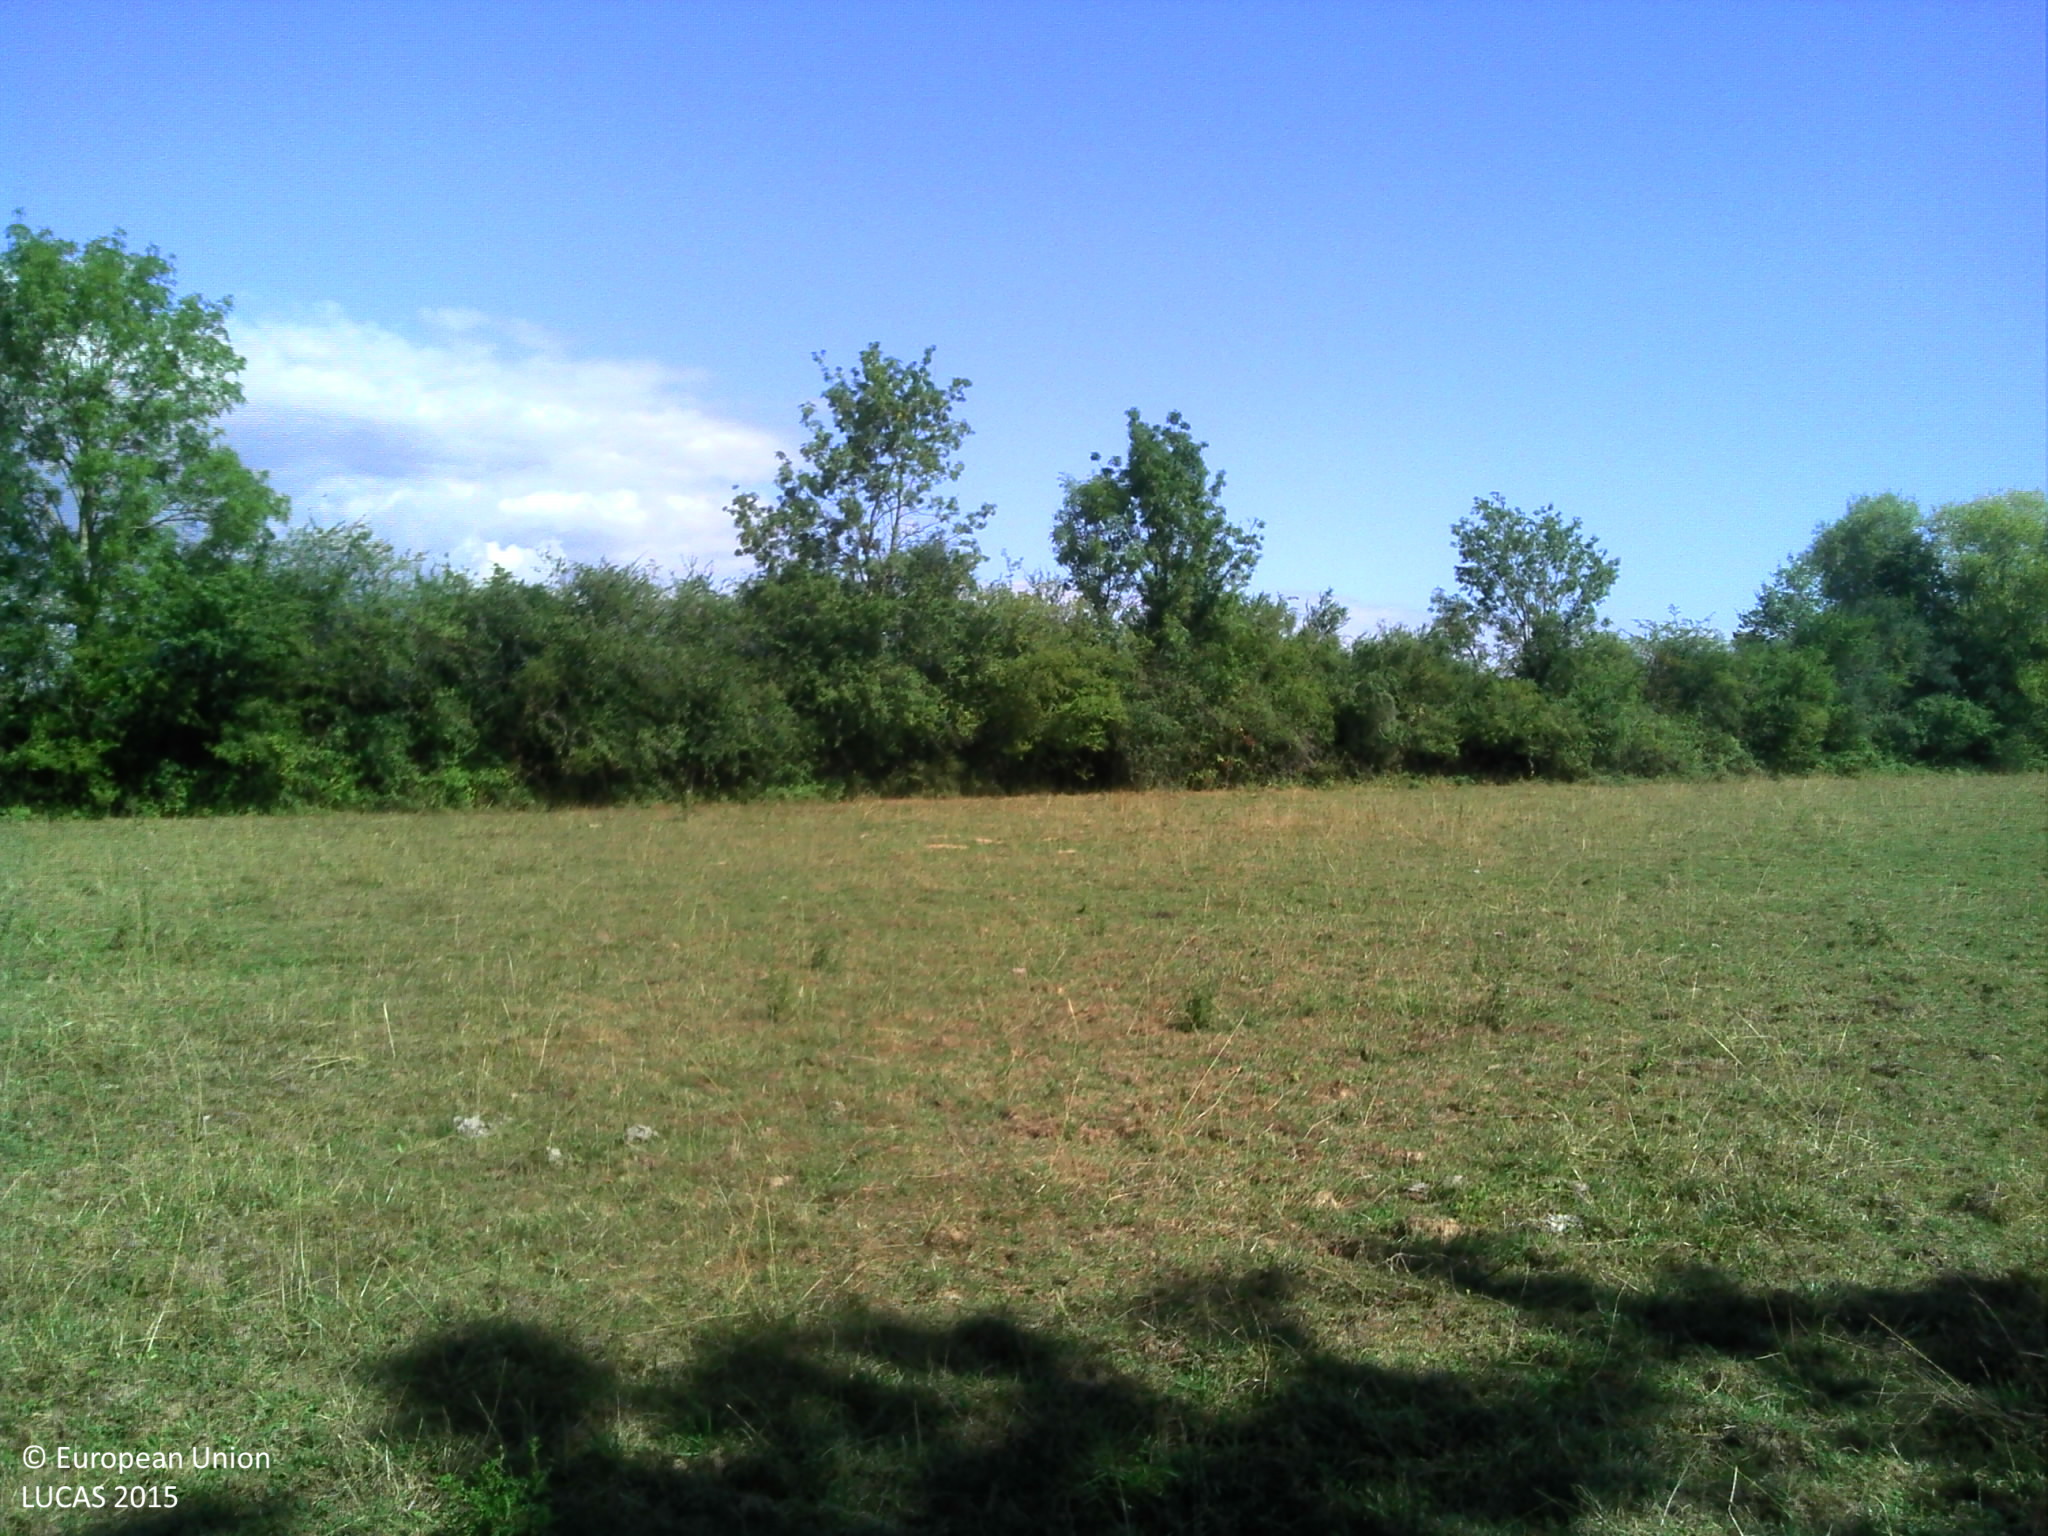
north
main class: Grassland
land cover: Grassland without tree/shrub cover
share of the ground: > 75 %
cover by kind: herbaceous plants 100 %
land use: Agriculture (excluding fallow land and kitchen gardens)
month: July
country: FR
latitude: 46.7378
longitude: 4.9629
